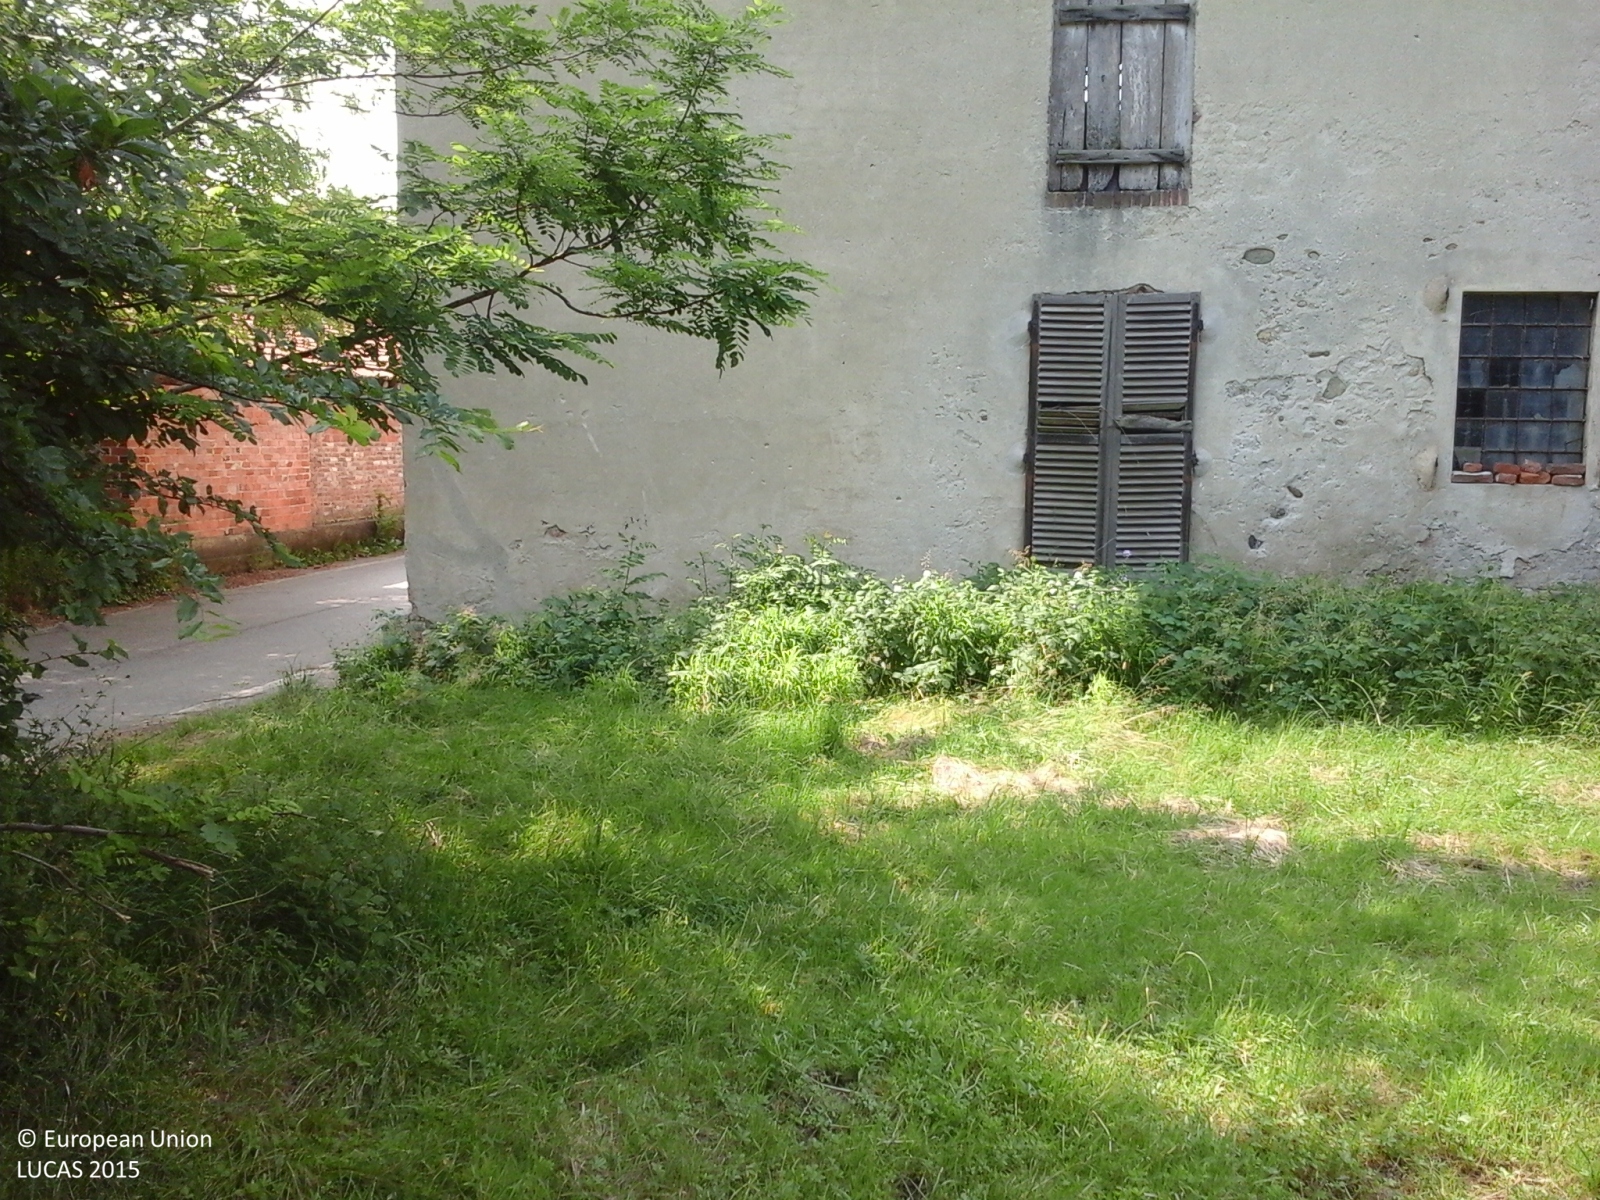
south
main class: Grassland
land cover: Grassland with sparse tree/shrub cover
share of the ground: > 75 %
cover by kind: herbaceous plants 90 %, broadleaved forest trees 5 %, shrubs 5 %
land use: Residential
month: May
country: IT
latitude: 45.2264
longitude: 7.6732
